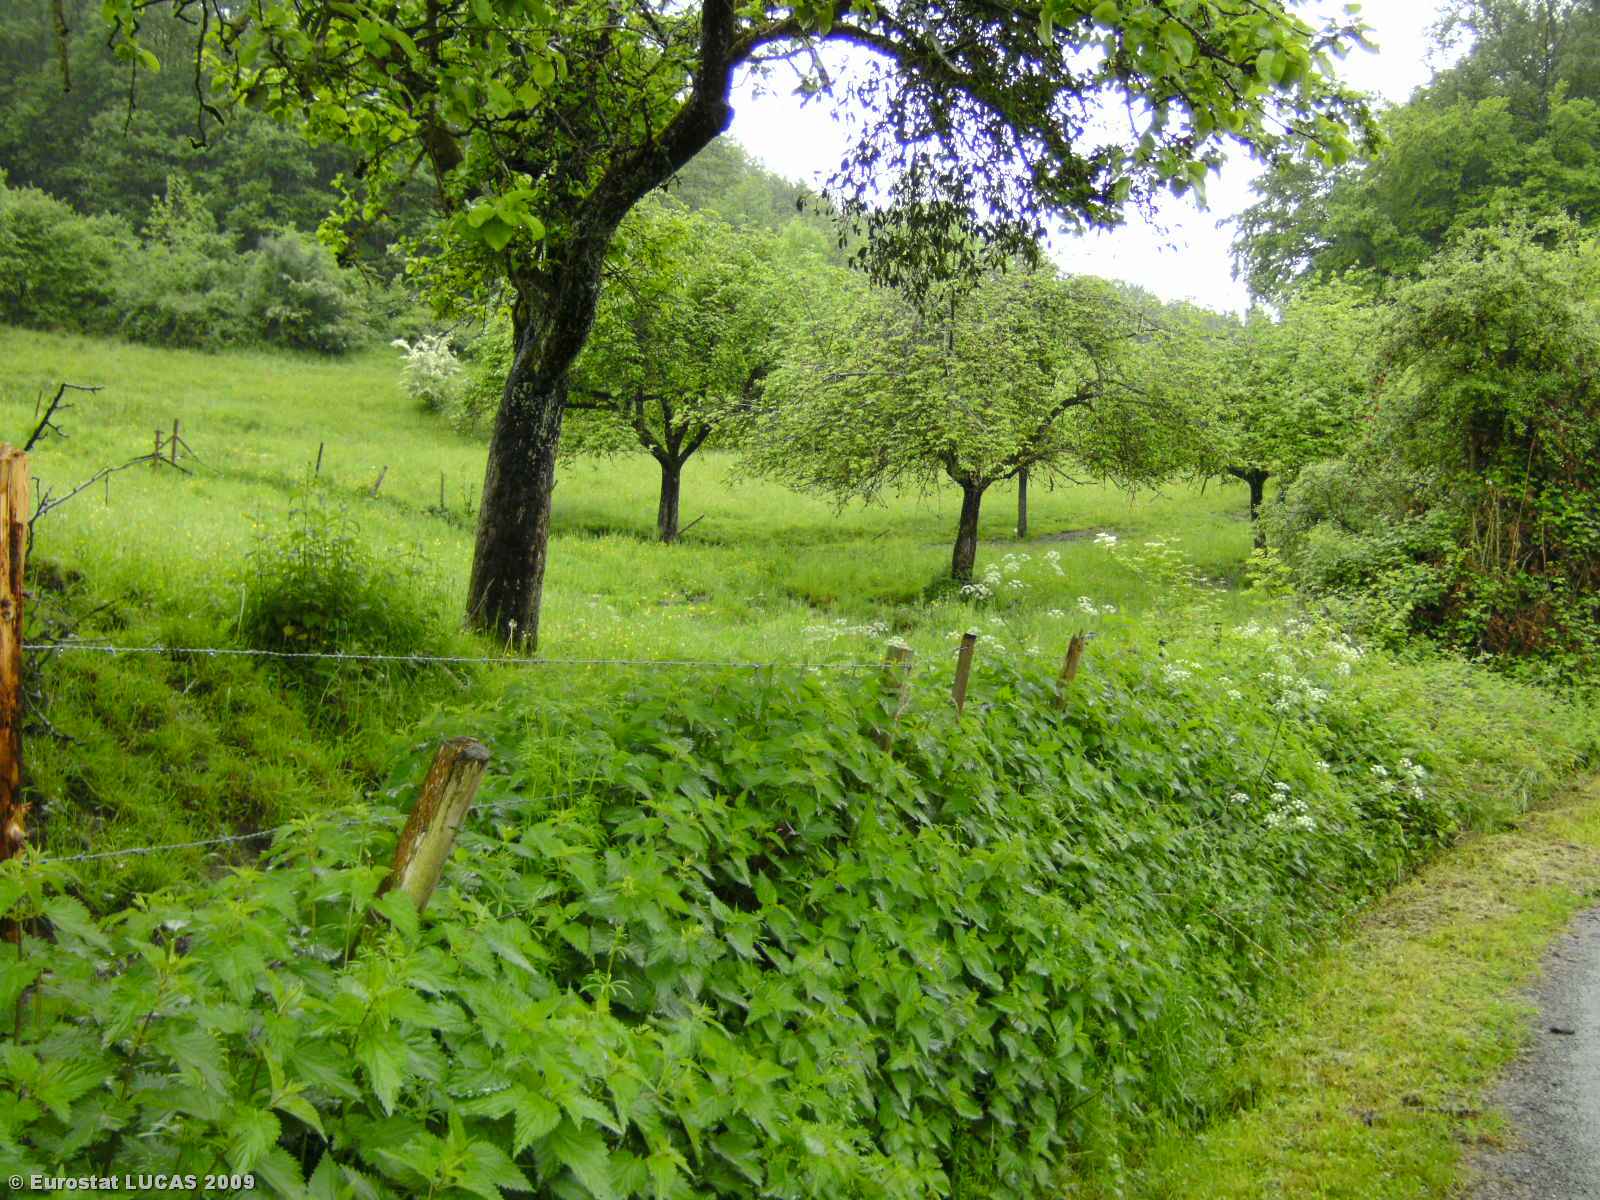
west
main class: Grassland
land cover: Grassland without tree/shrub cover
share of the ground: > 75 %
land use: Agriculture (excluding fallow land and kitchen gardens)
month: May
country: LU
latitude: 49.8547
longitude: 6.3136
